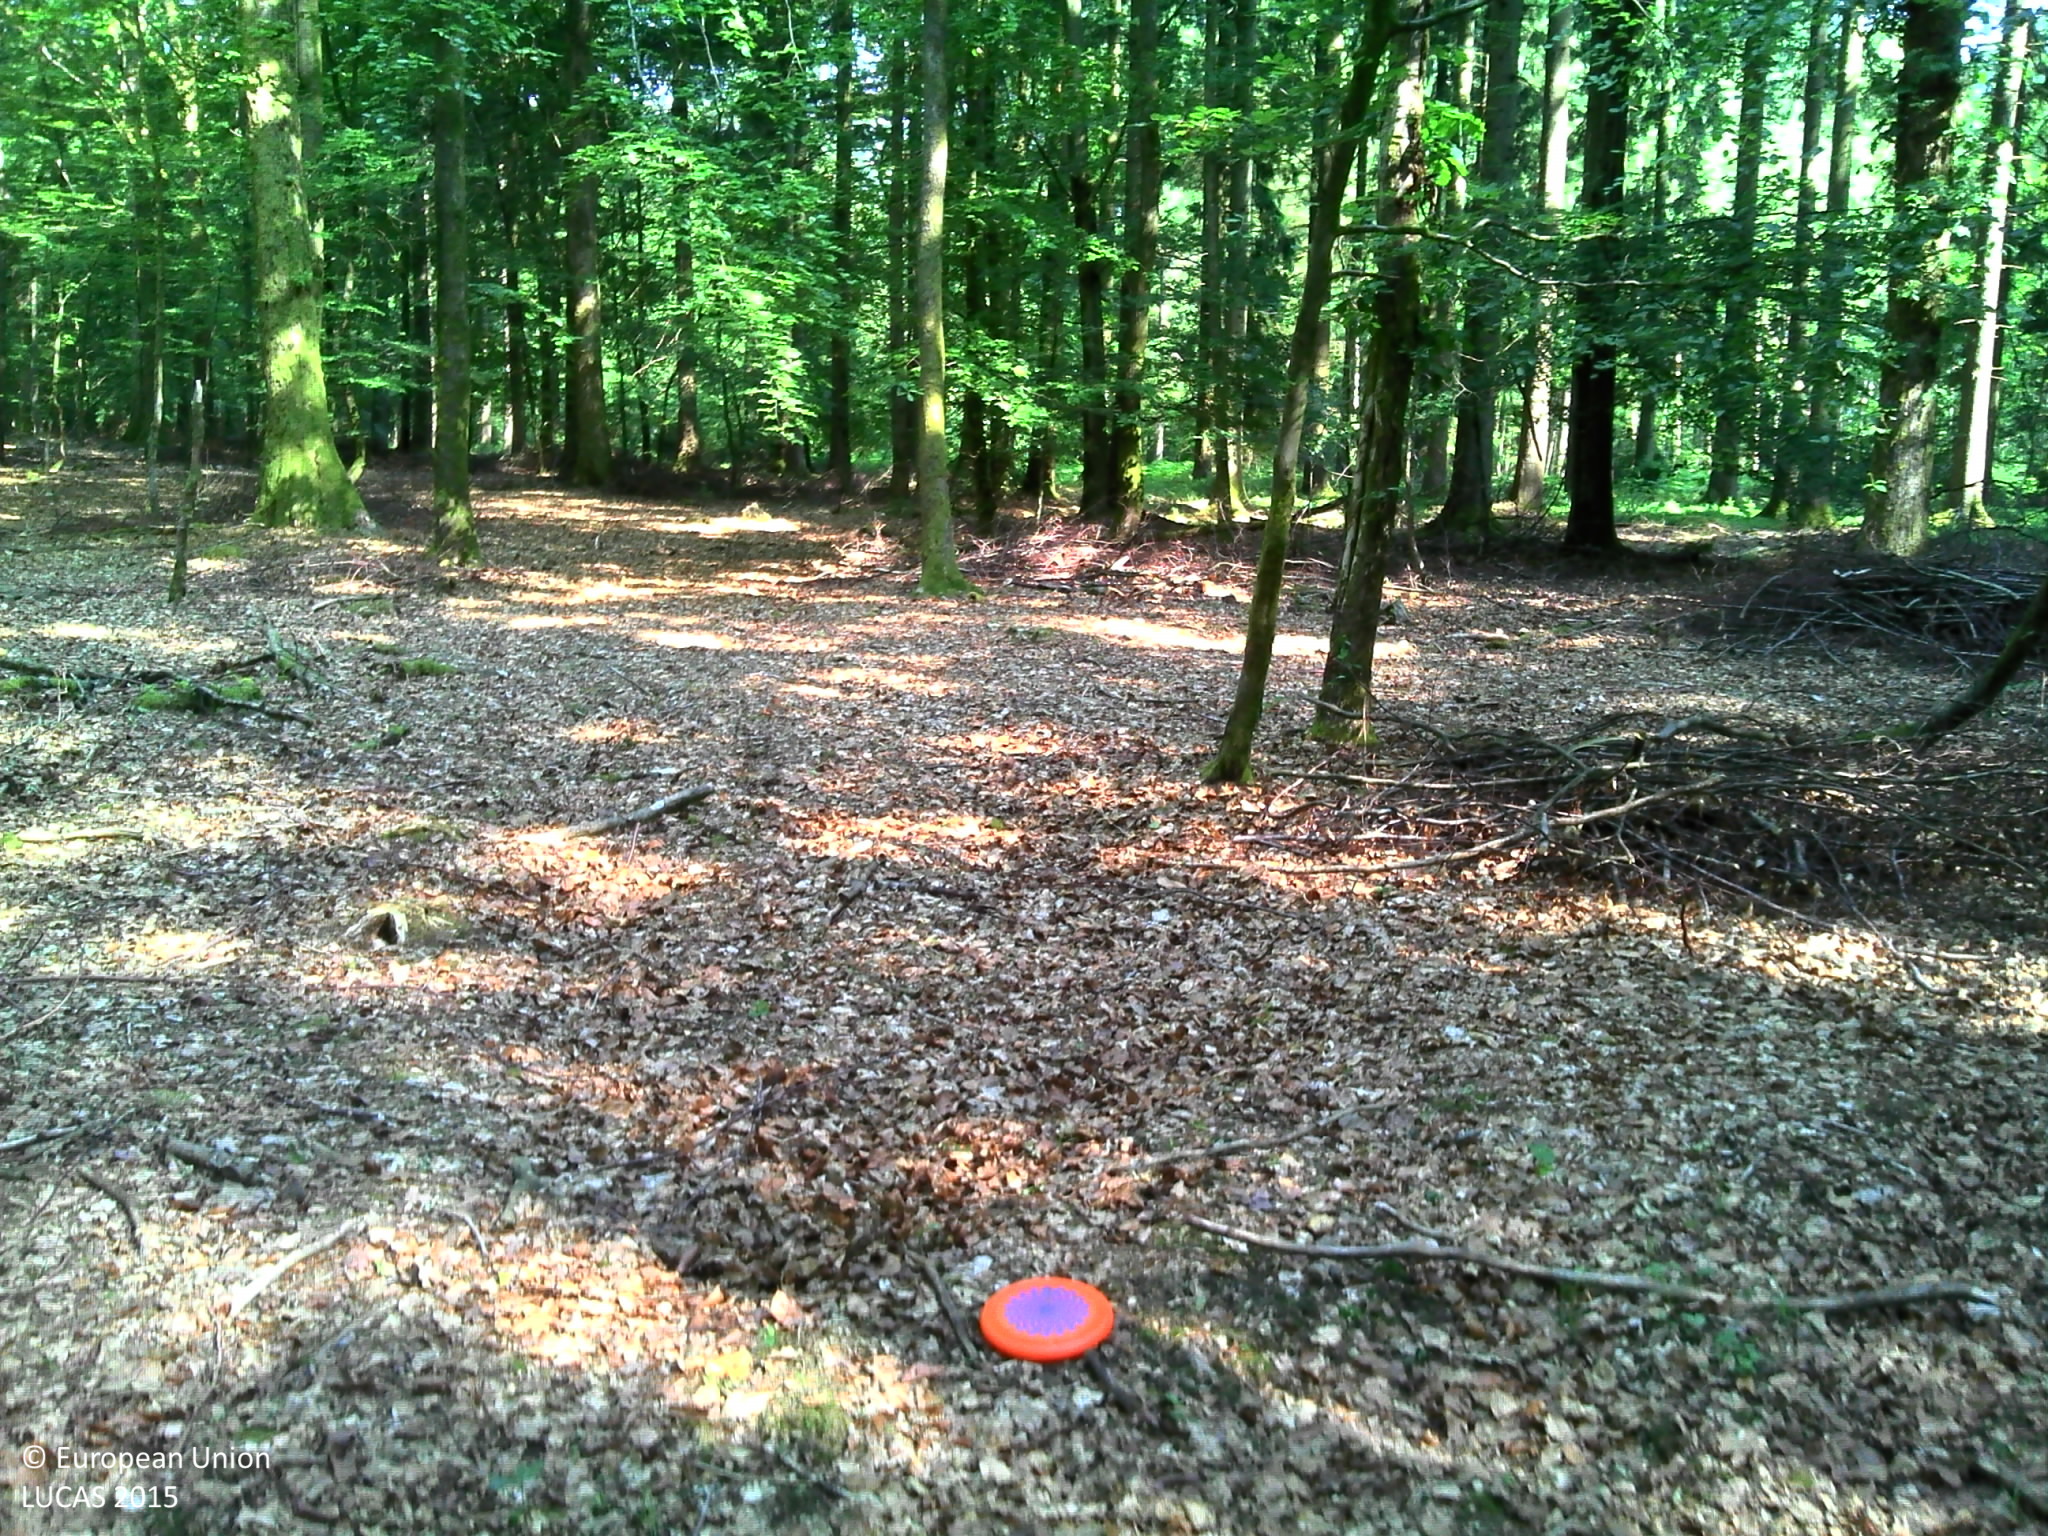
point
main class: Woodland
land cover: Broadleaved woodland
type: acidophilous oak and oak-birch forest
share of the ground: > 75 %
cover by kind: broadleaved forest trees 95 %, unconsolidated bare surface 5 %
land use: Forestry
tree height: > 5 m
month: June
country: BE
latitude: 49.9253
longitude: 4.8849
